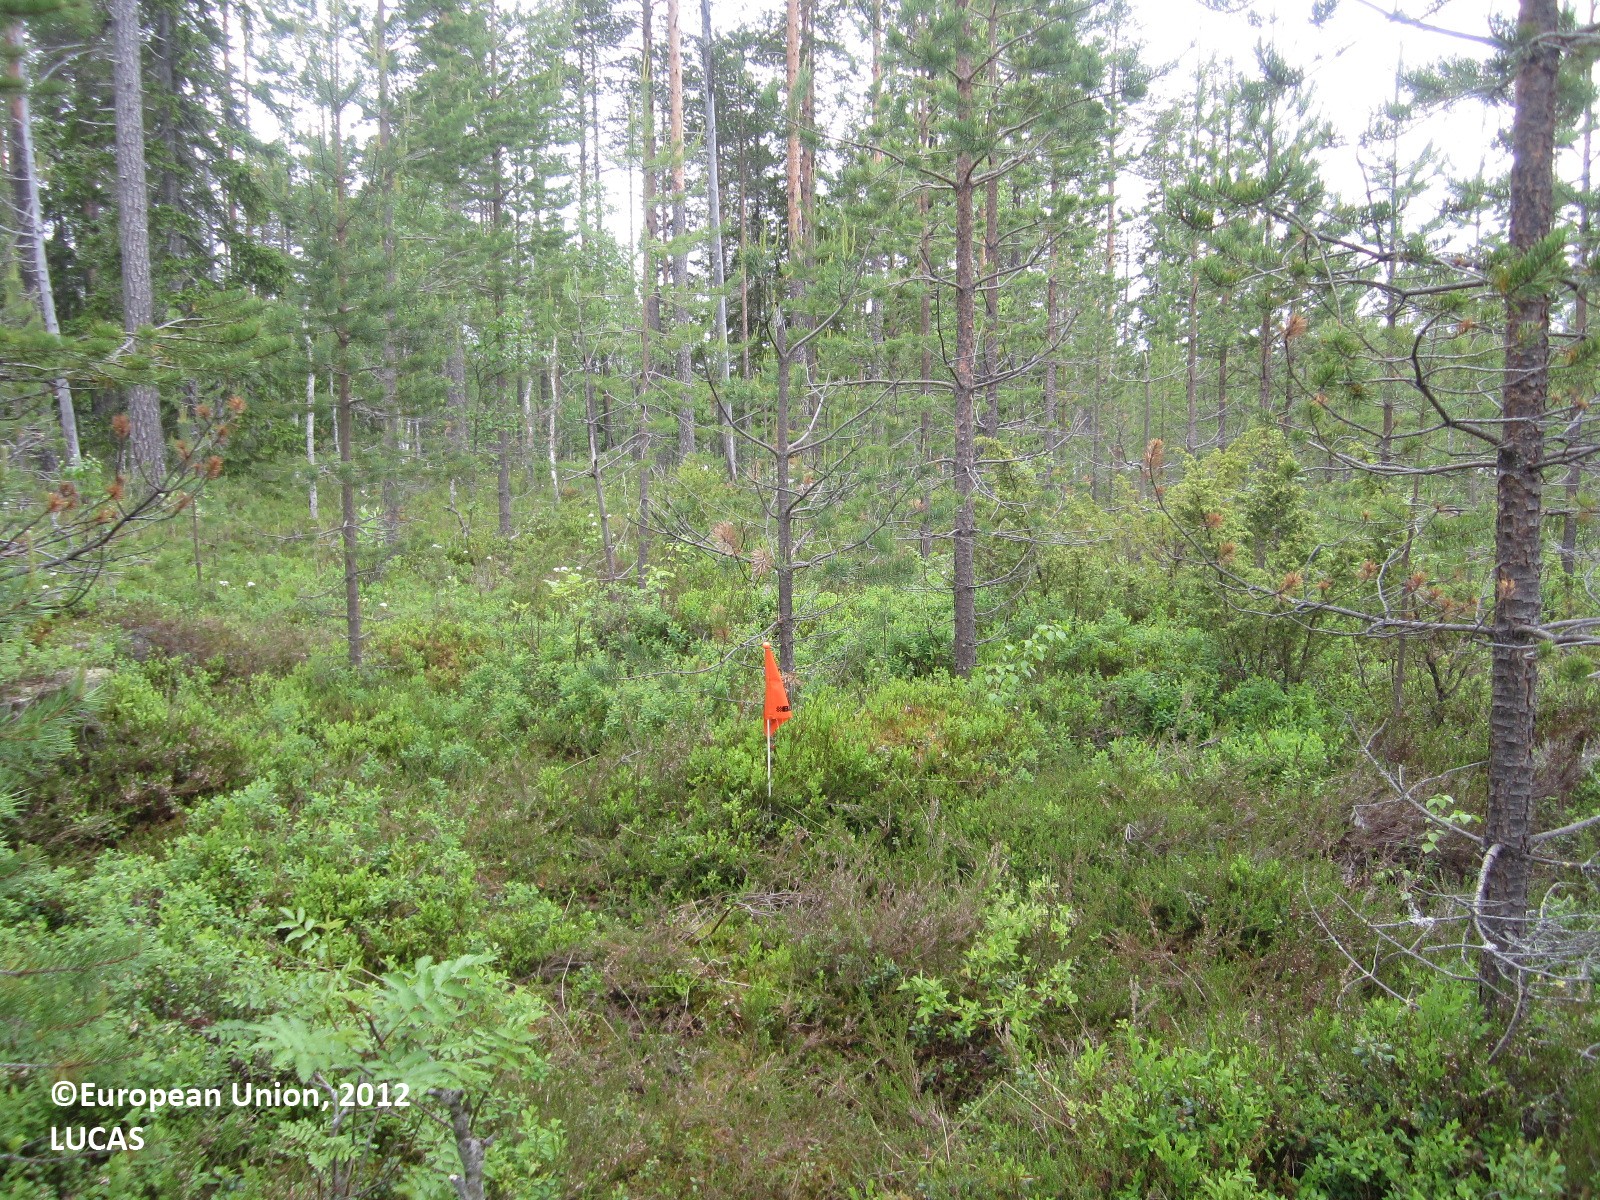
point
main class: Woodland
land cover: Pine dominated coniferous woodland
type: boreal forest
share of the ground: 25 - 50 %
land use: Forestry
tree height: > 5 m
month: June
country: FI
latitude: 64.7253
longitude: 29.9389
